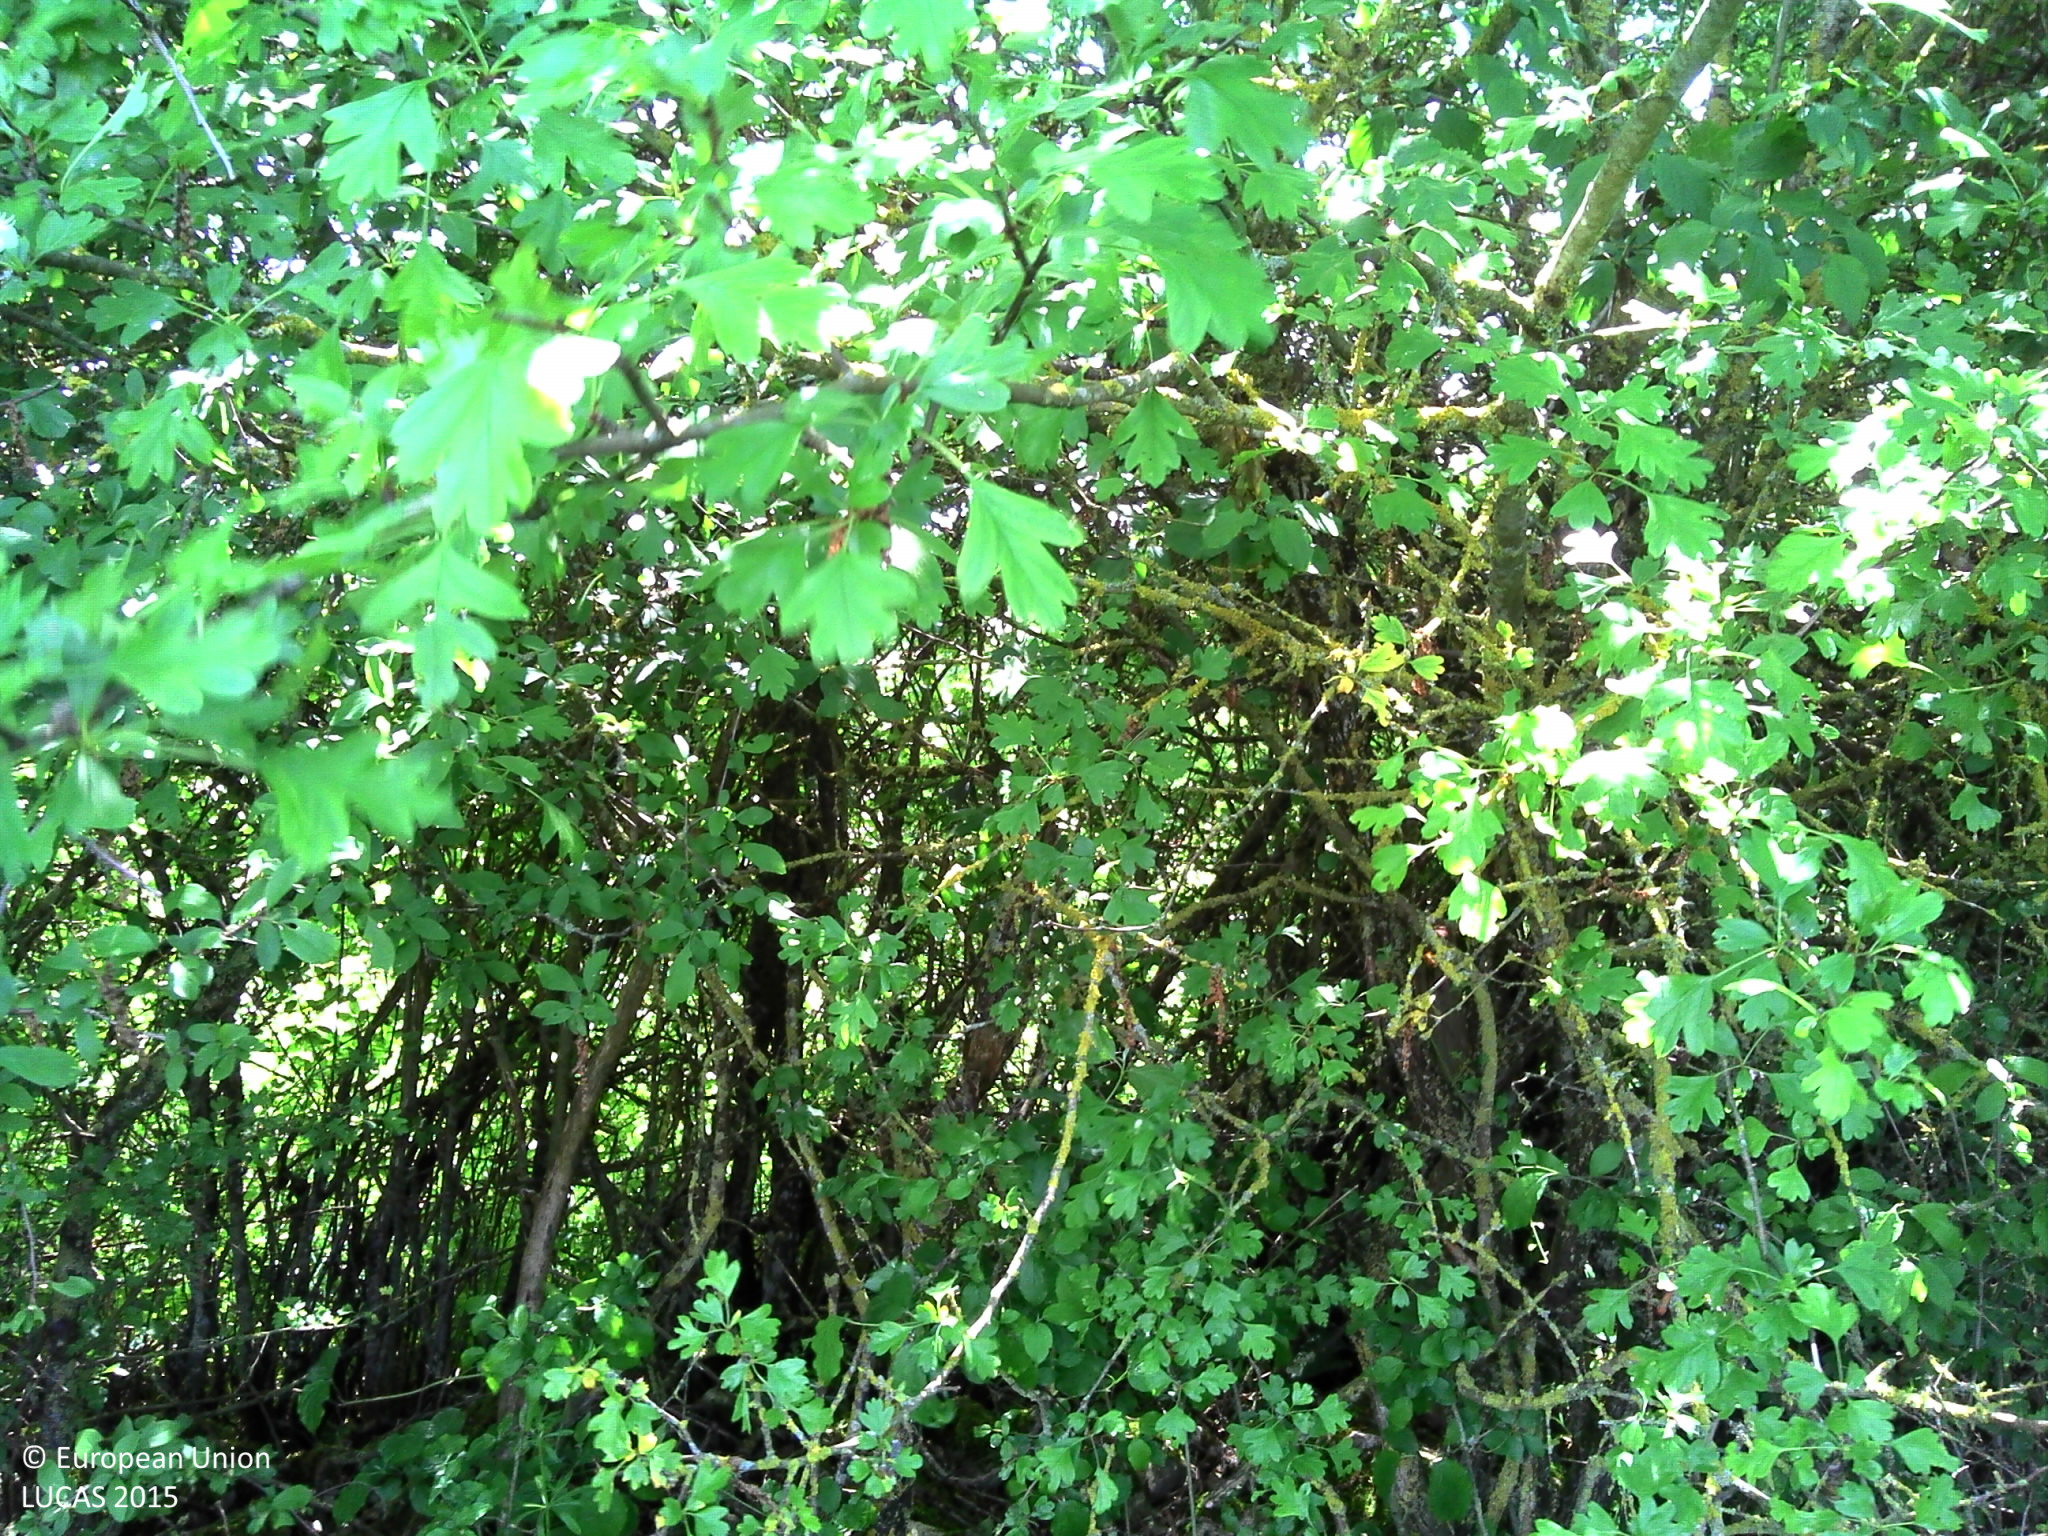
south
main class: Grassland
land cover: Grassland without tree/shrub cover
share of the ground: > 75 %
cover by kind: herbaceous plants 100 %
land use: Agriculture (excluding fallow land and kitchen gardens)
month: May
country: FR
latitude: 44.3212
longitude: 3.1213
